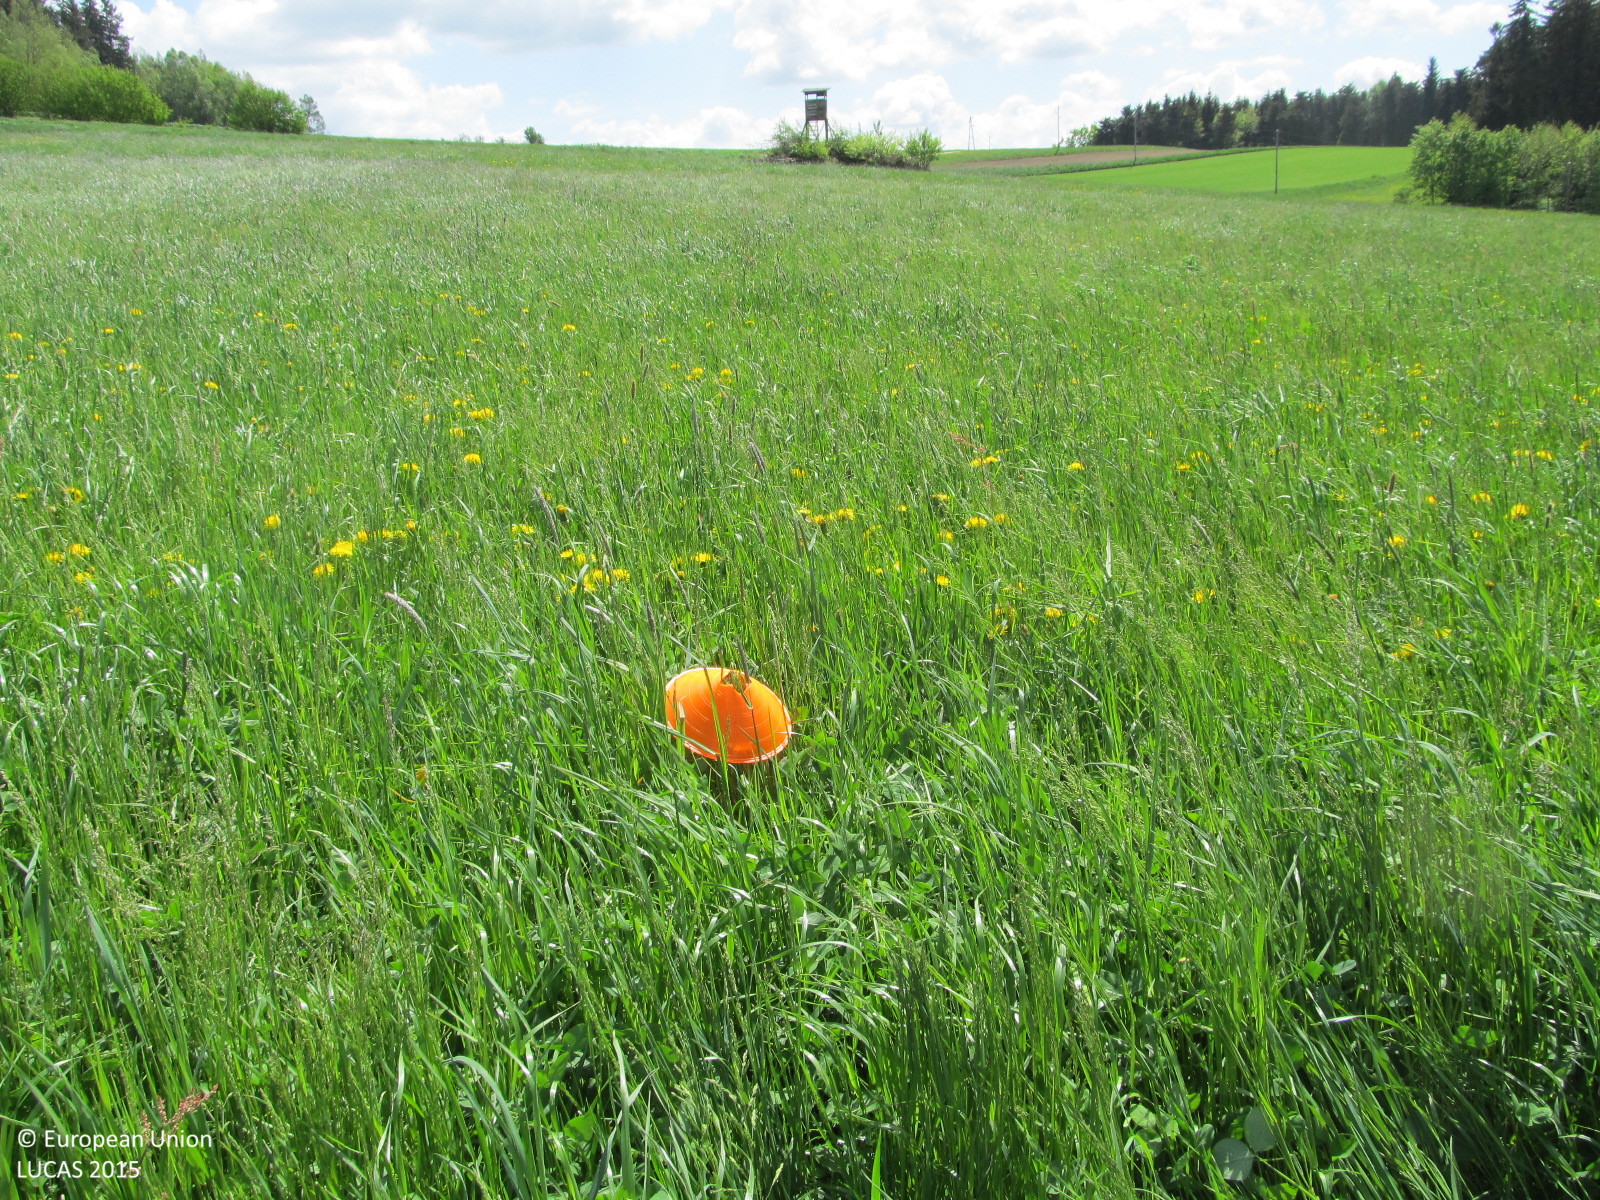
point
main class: Grassland
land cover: Grassland without tree/shrub cover
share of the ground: > 75 %
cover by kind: herbaceous plants 100 %
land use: Agriculture (excluding fallow land and kitchen gardens)
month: May
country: AT
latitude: 48.5277
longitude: 15.3240
